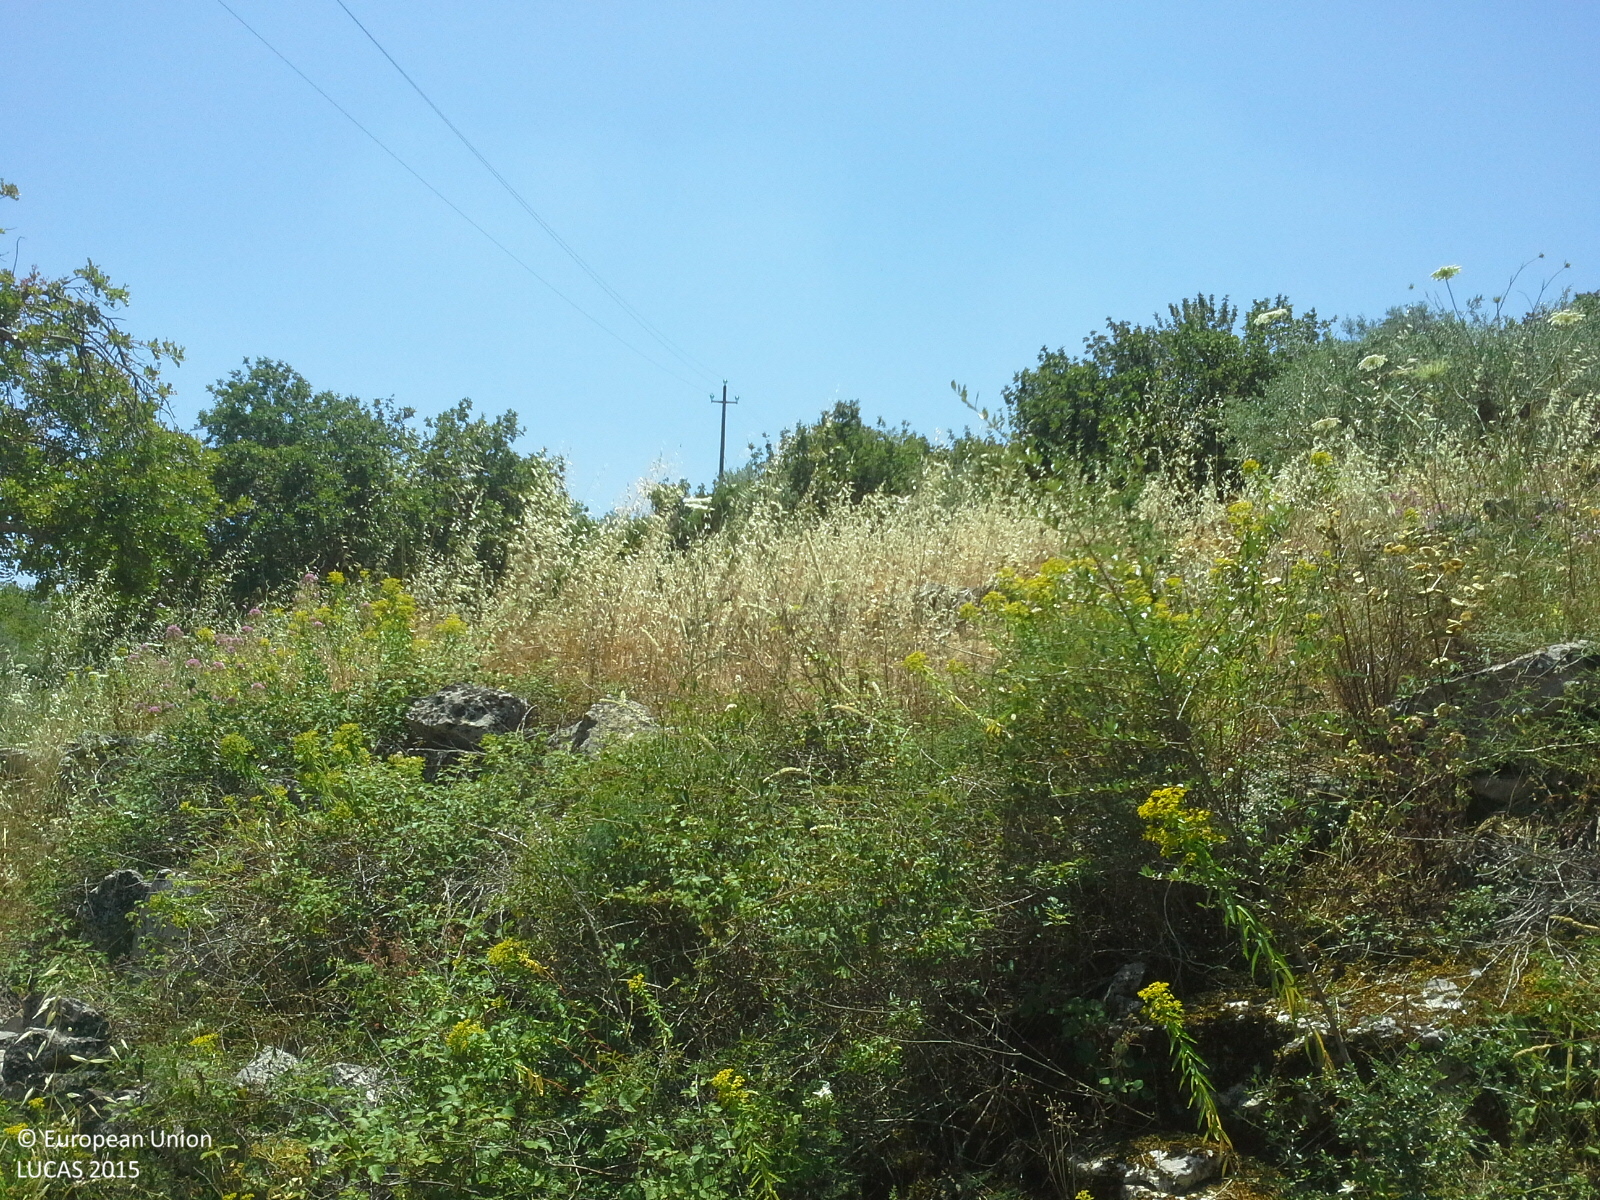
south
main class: Grassland
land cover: Grassland with sparse tree/shrub cover
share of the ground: > 75 %
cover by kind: herbaceous plants 95 %, coniferous forest trees 5 %
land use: Agriculture (excluding fallow land and kitchen gardens)
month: June
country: IT
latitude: 36.9147
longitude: 14.8443
